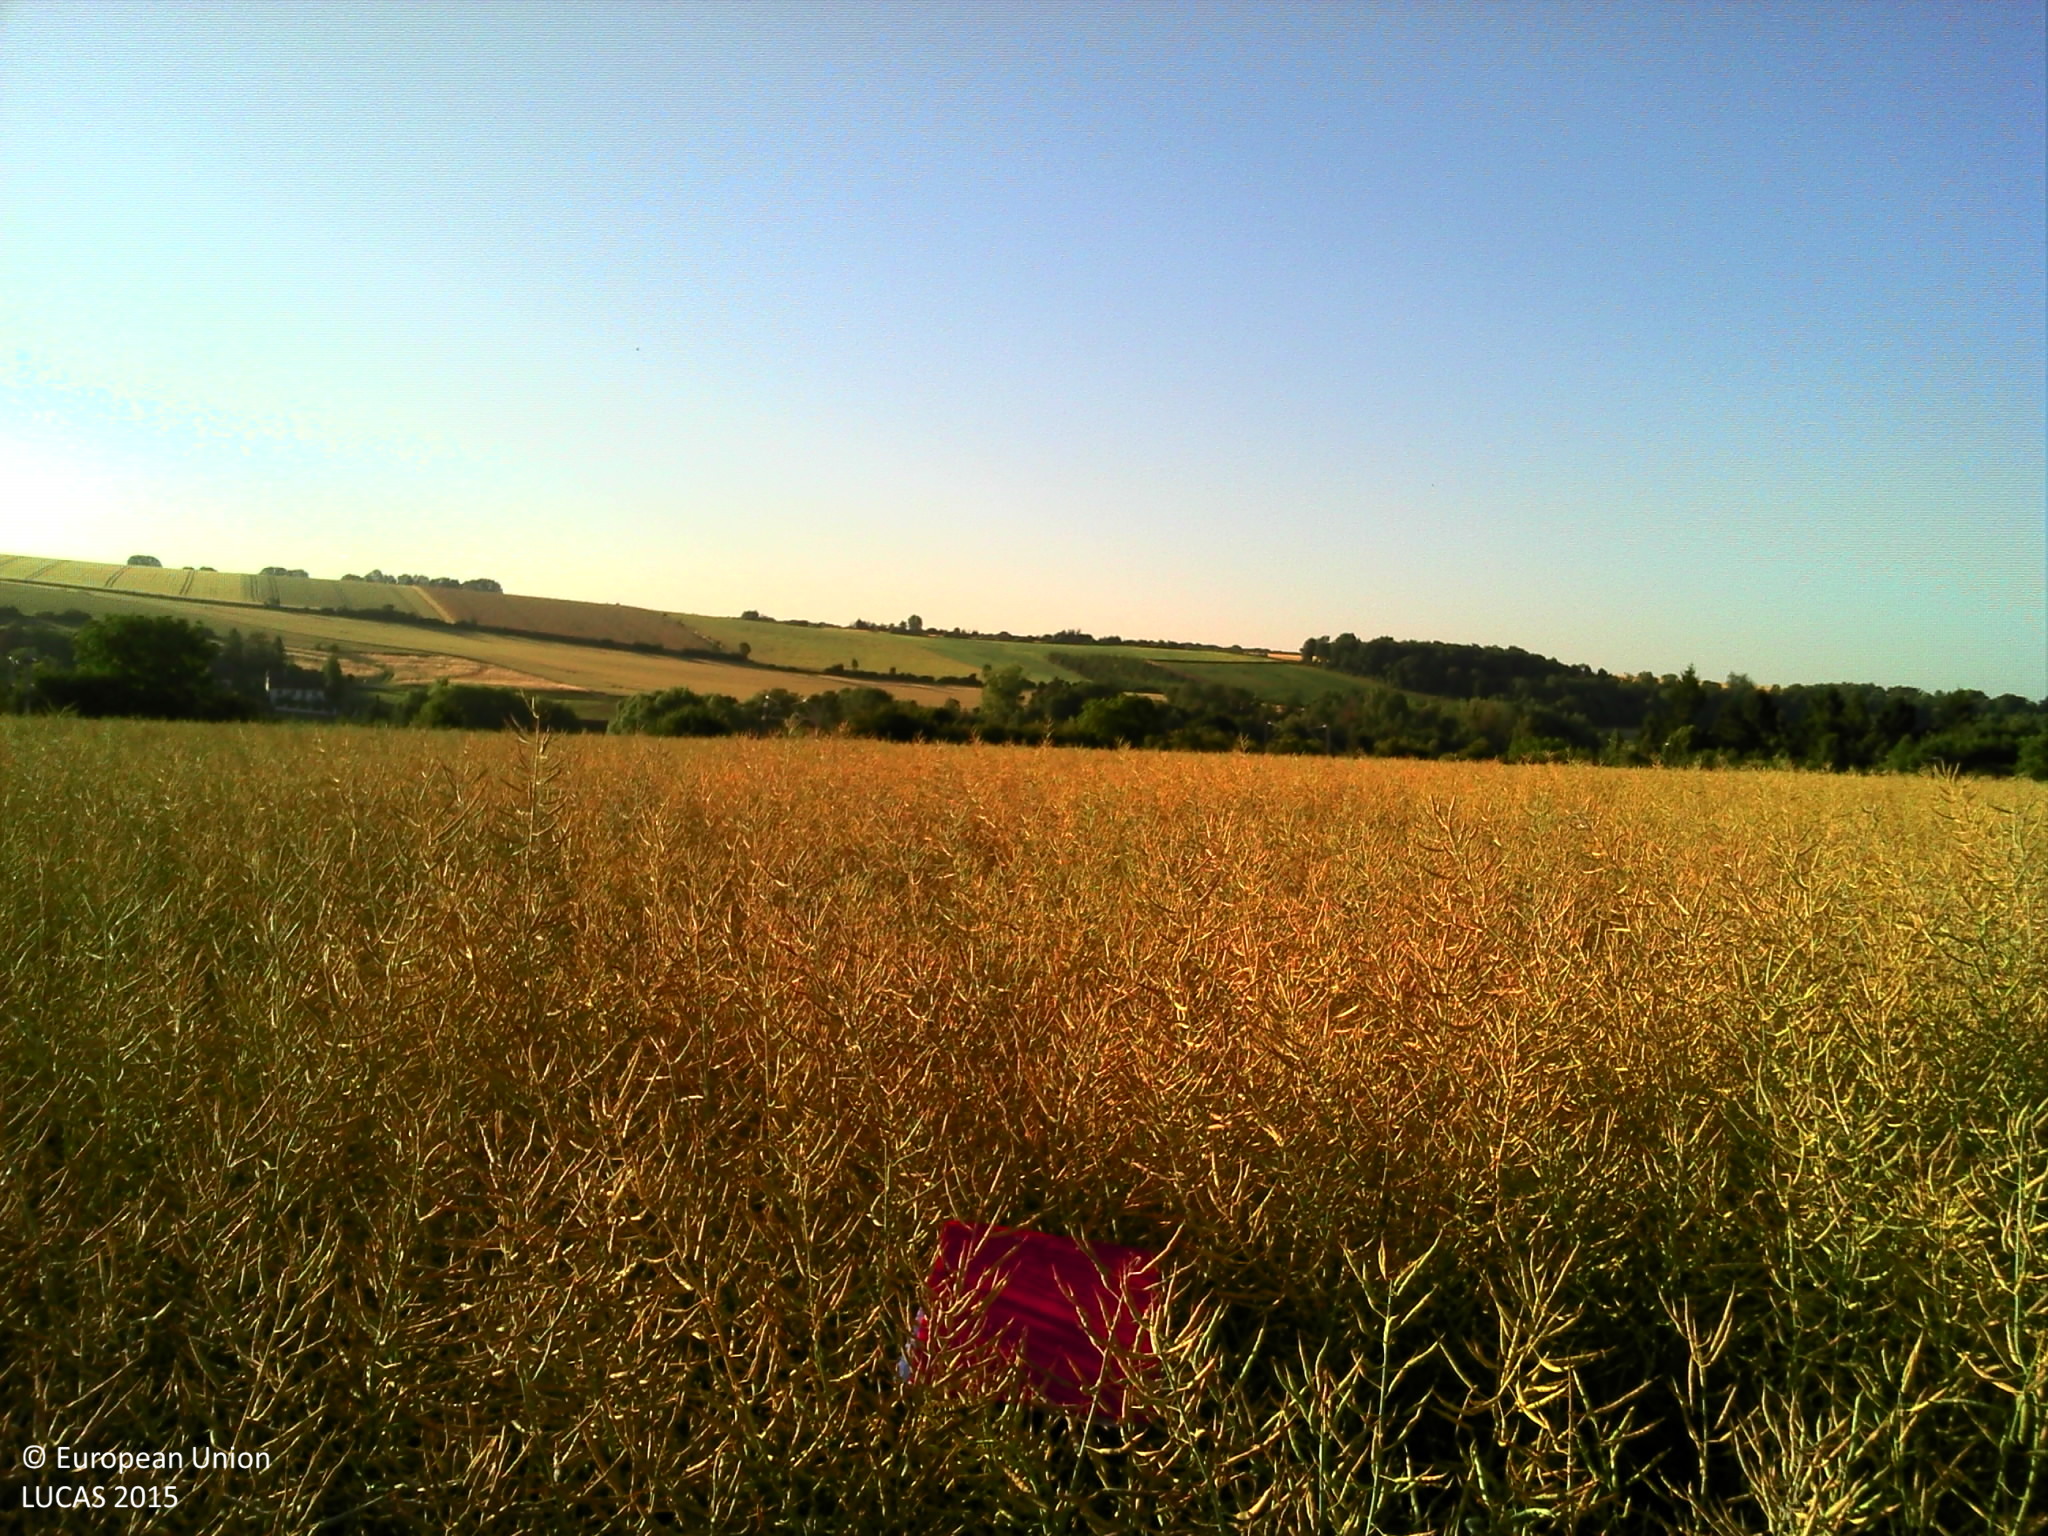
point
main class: Cropland
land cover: Rape and turnip rape
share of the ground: > 75 %
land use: Agriculture (excluding fallow land and kitchen gardens)
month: June
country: FR
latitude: 49.4437
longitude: 2.4157
